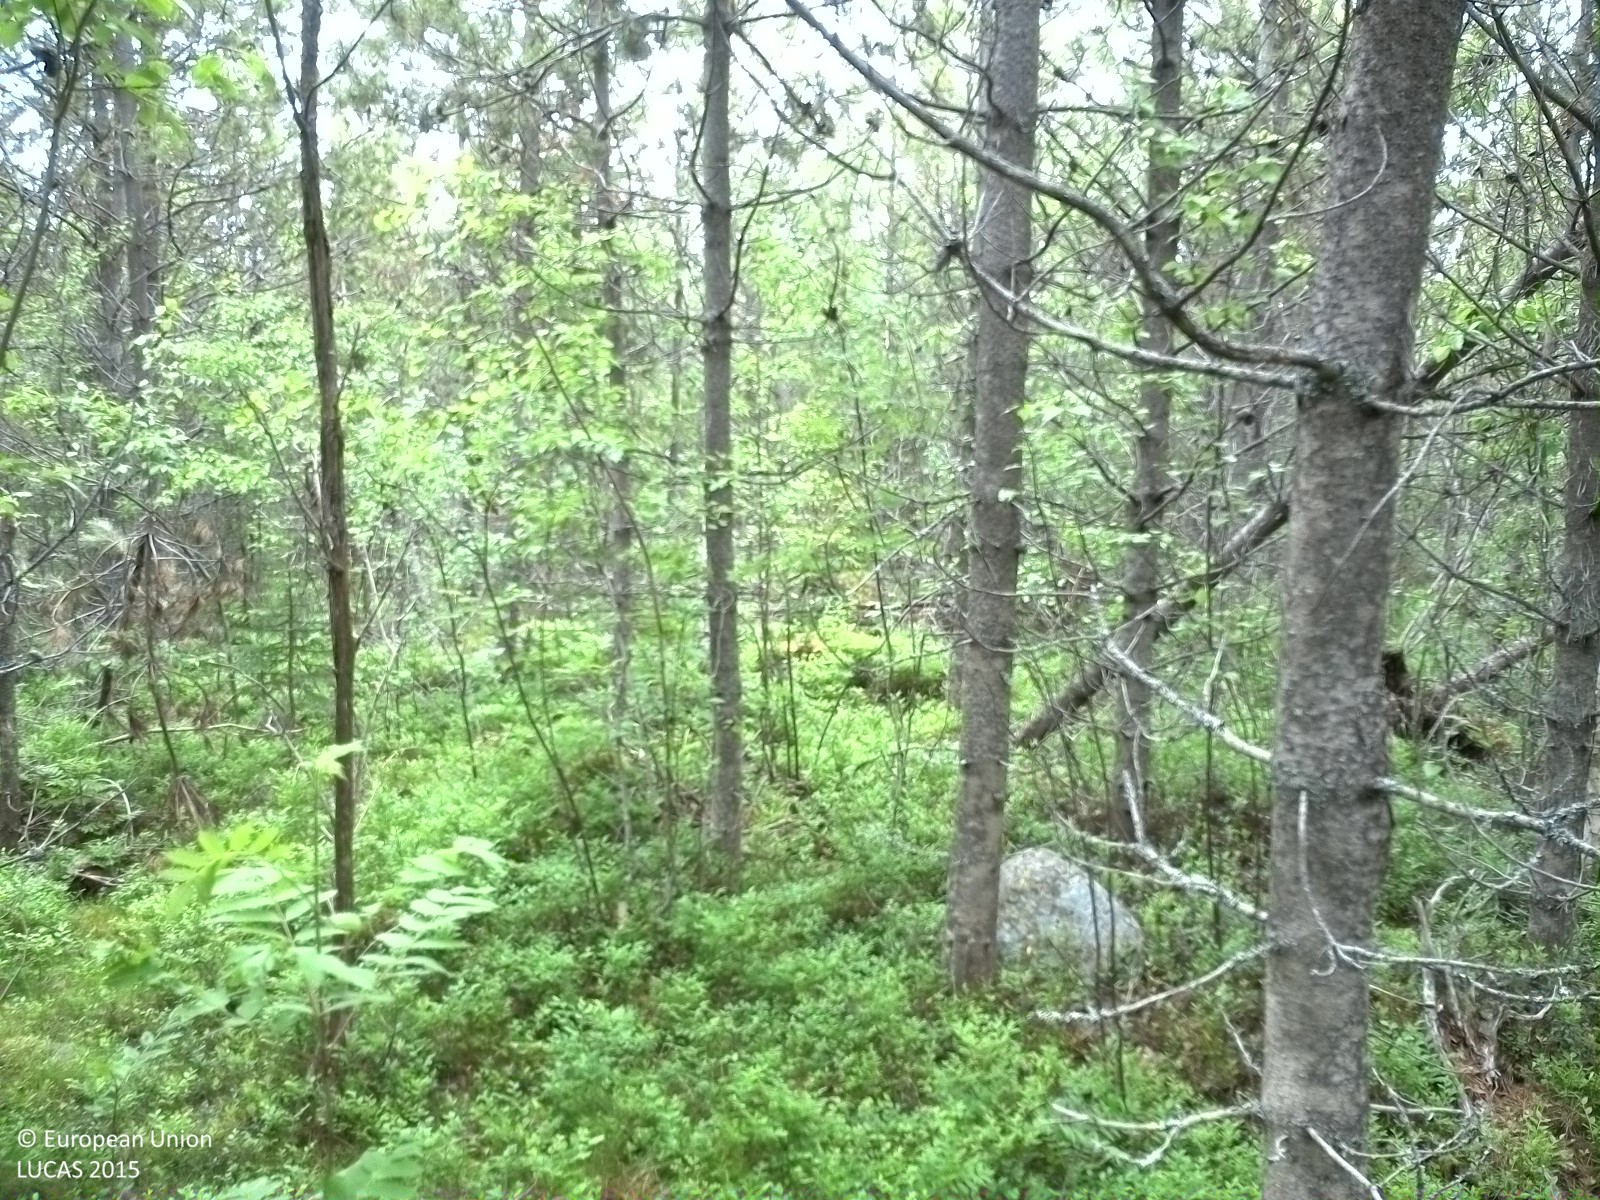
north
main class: Woodland
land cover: Pine dominated coniferous woodland
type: exotic forest
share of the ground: > 75 %
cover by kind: coniferous forest trees 75 %, shrubs 10 %, broadleaved forest trees 5 %, herbaceous plants 5 %, lichens and mosses 5 %
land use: Forestry
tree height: > 5 m
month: July
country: SE
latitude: 62.1339
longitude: 16.3673
